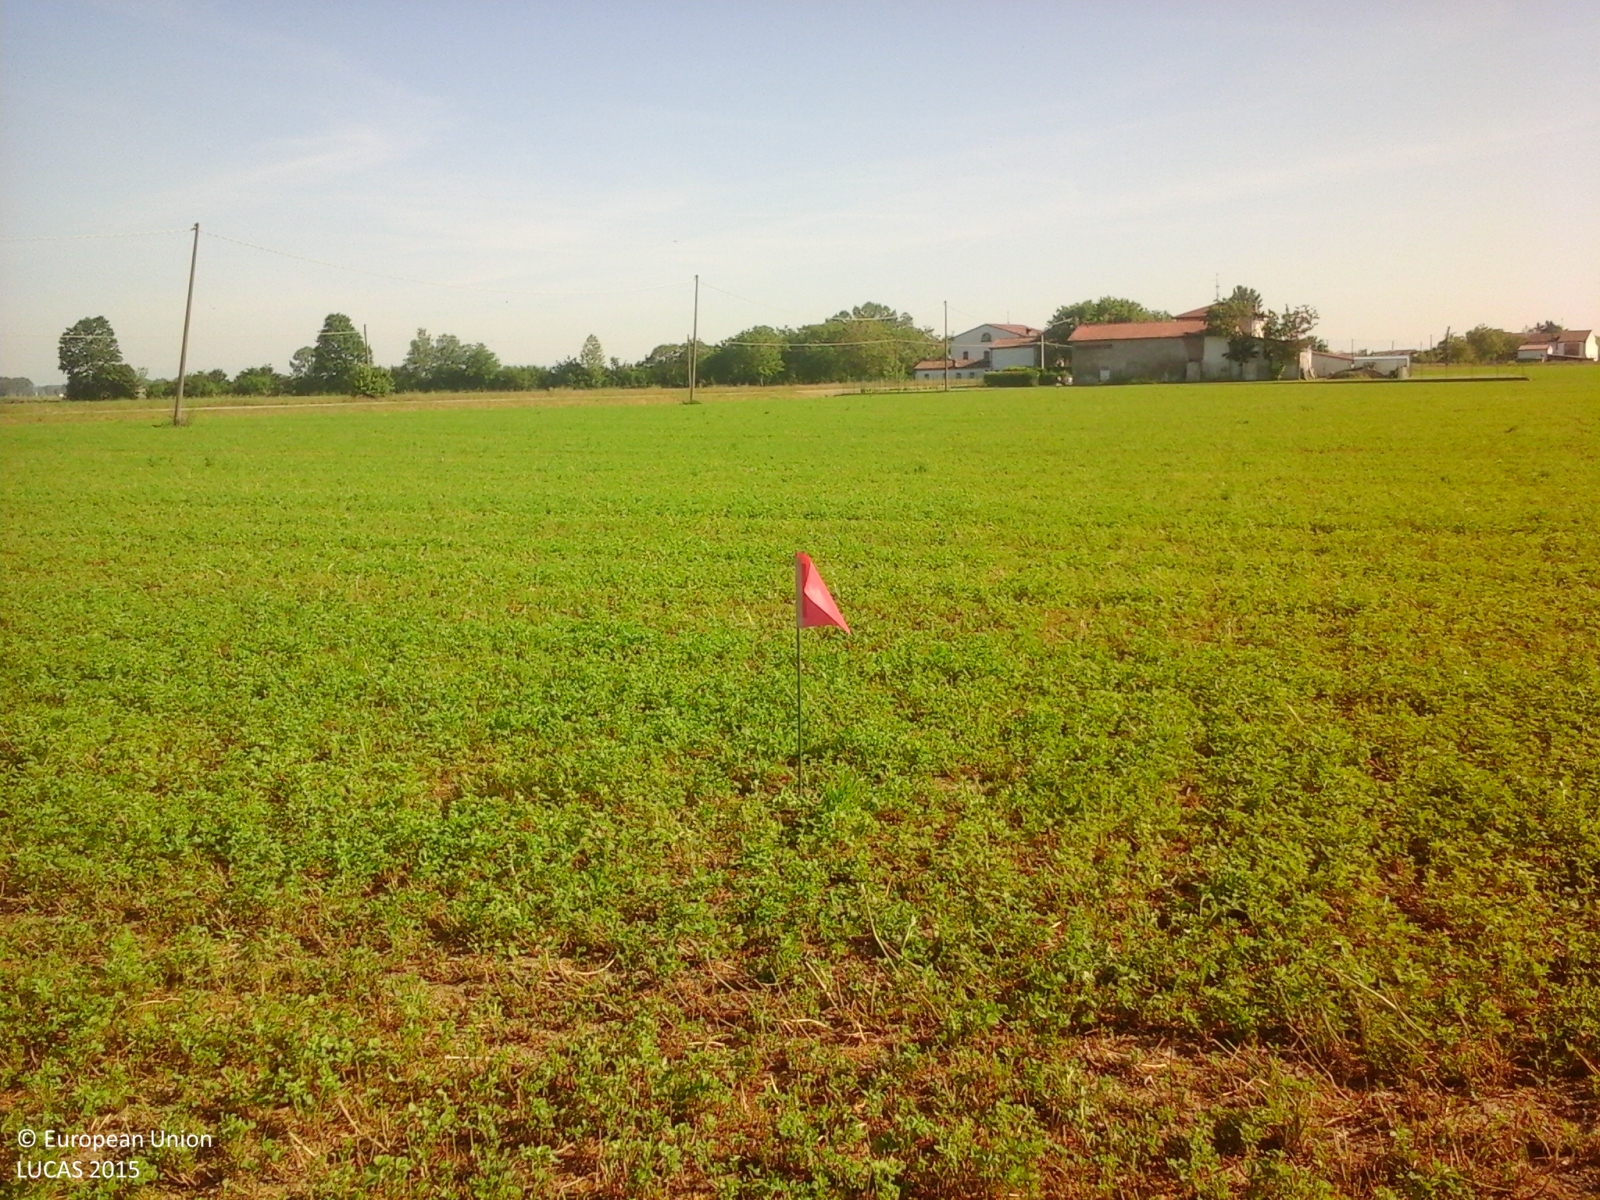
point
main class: Cropland
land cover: Lucerne
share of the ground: > 75 %
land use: Agriculture (excluding fallow land and kitchen gardens)
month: May
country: IT
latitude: 44.9967
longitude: 10.7976
